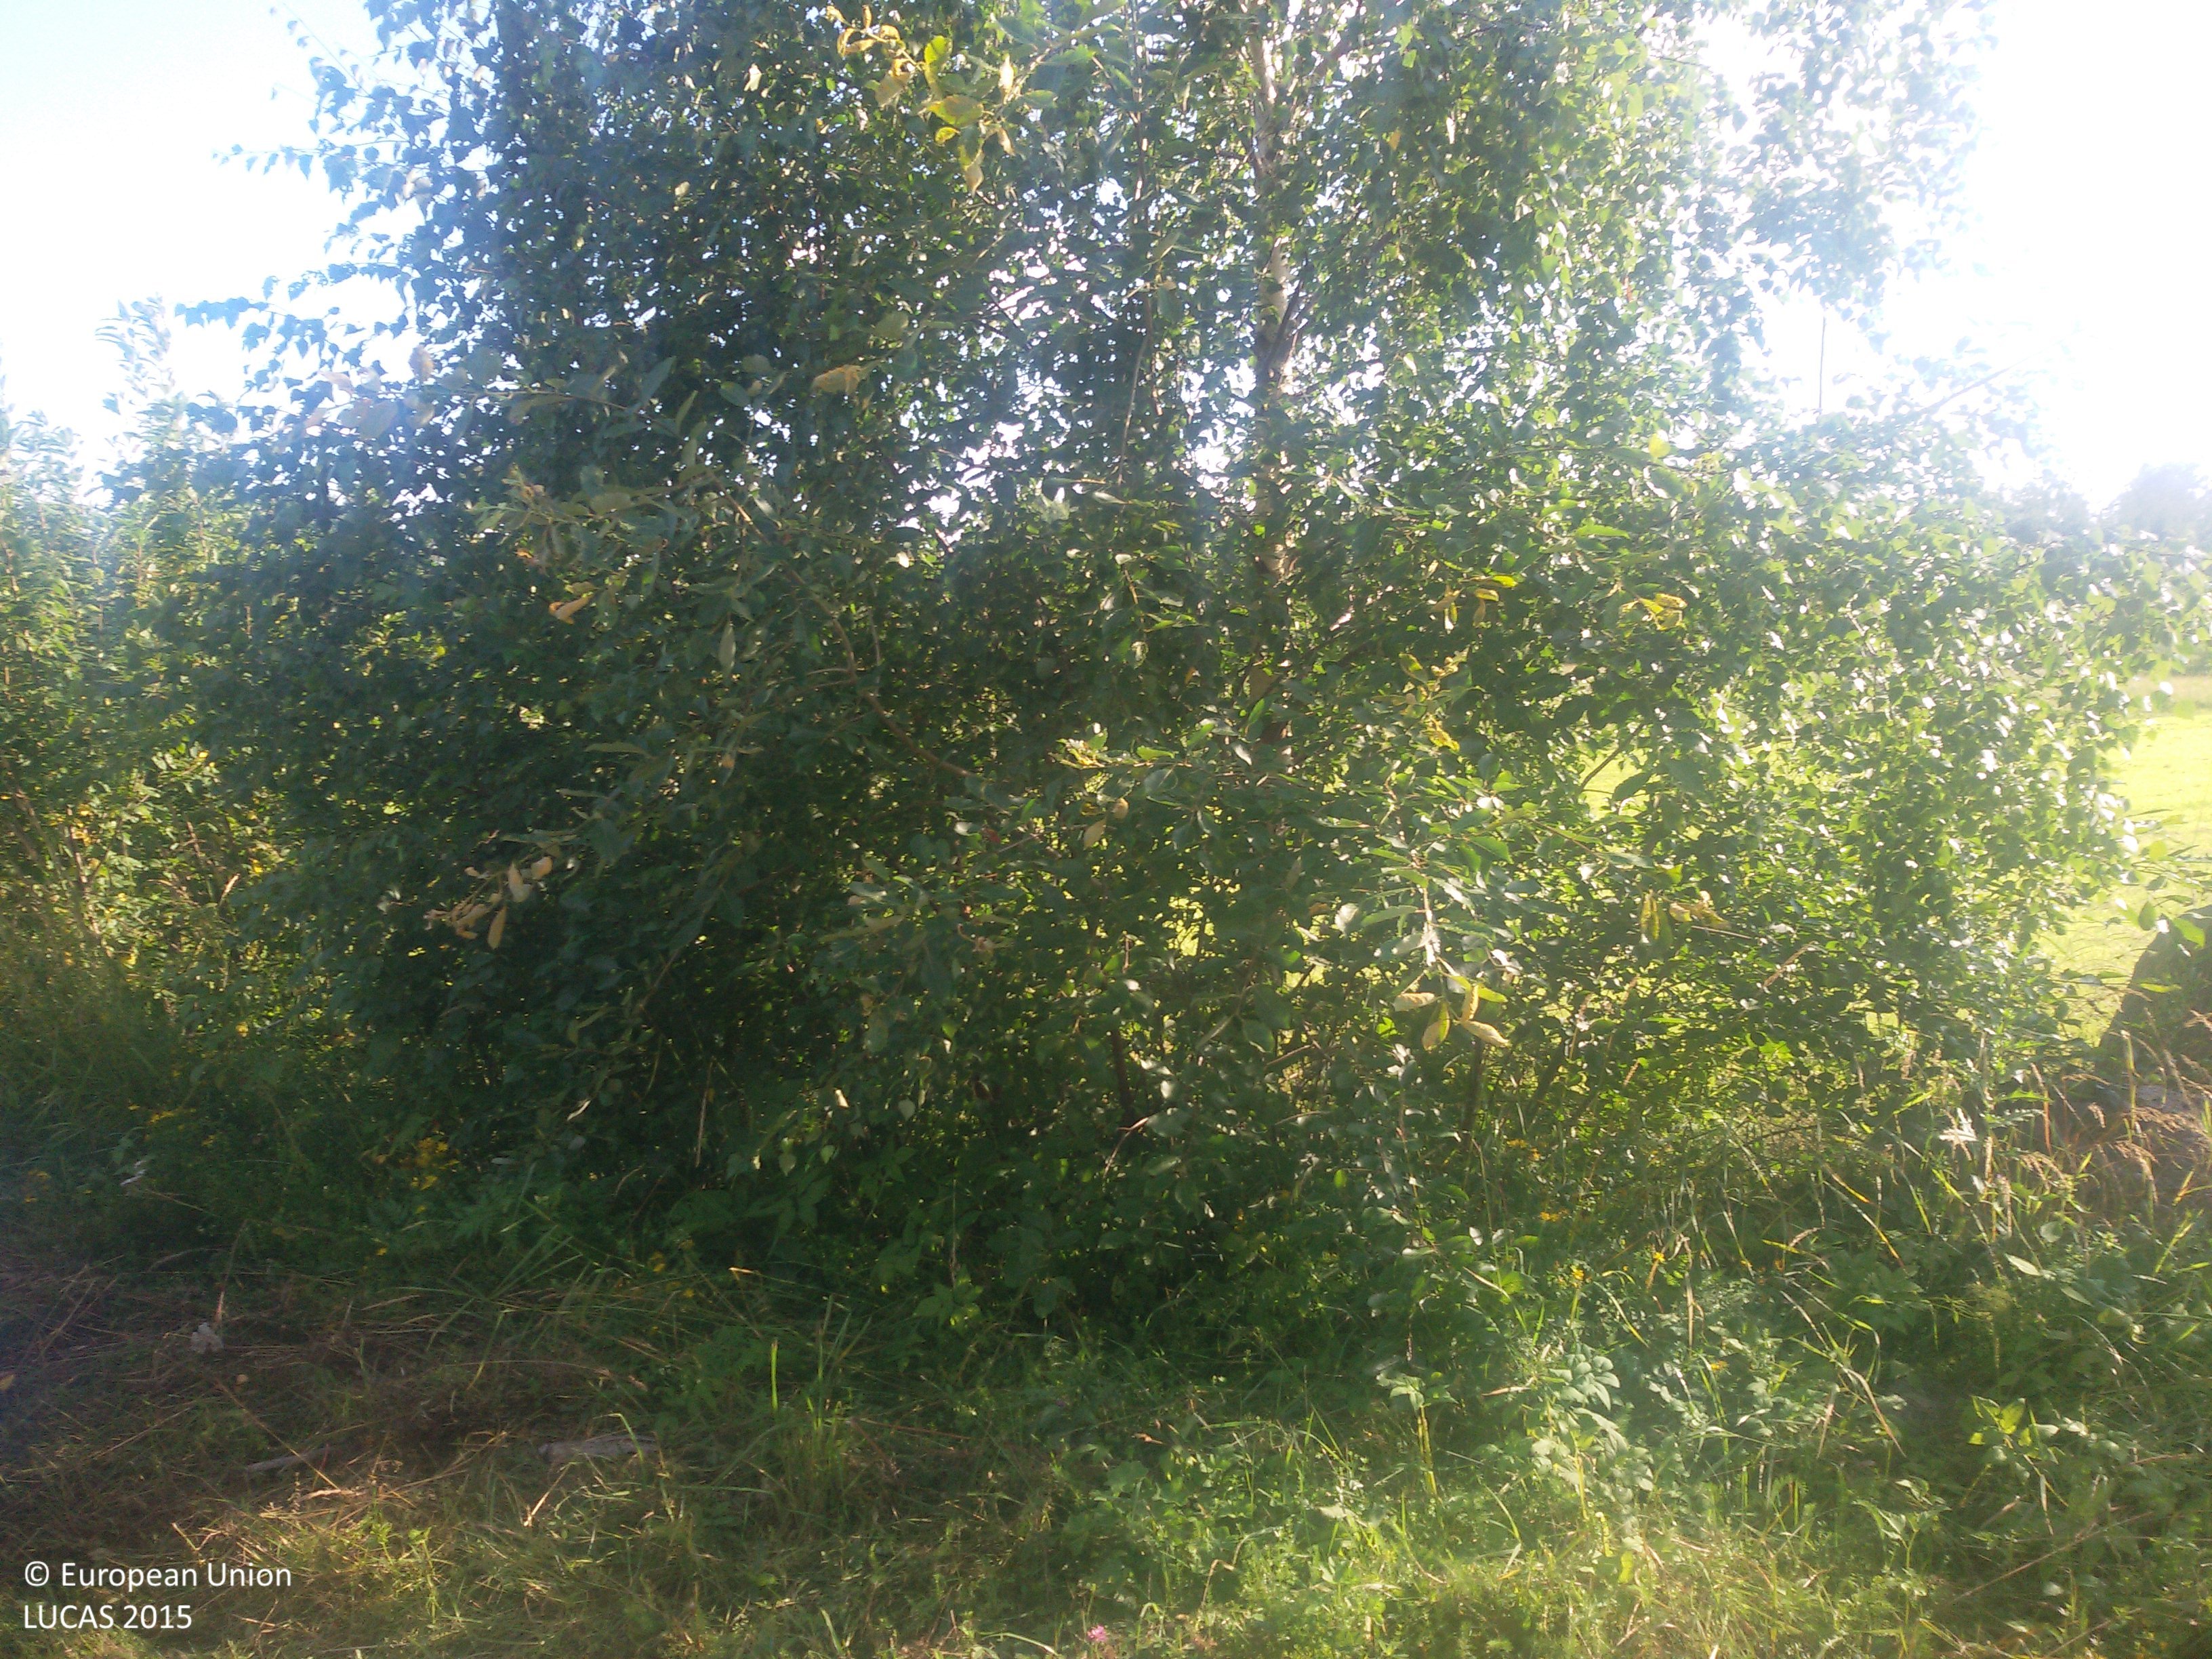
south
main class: Grassland
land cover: Grassland with sparse tree/shrub cover
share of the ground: > 75 %
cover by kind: herbaceous plants 95 %, broadleaved forest trees 5 %
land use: Residential
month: August
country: SE
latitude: 60.6020
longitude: 16.6543
